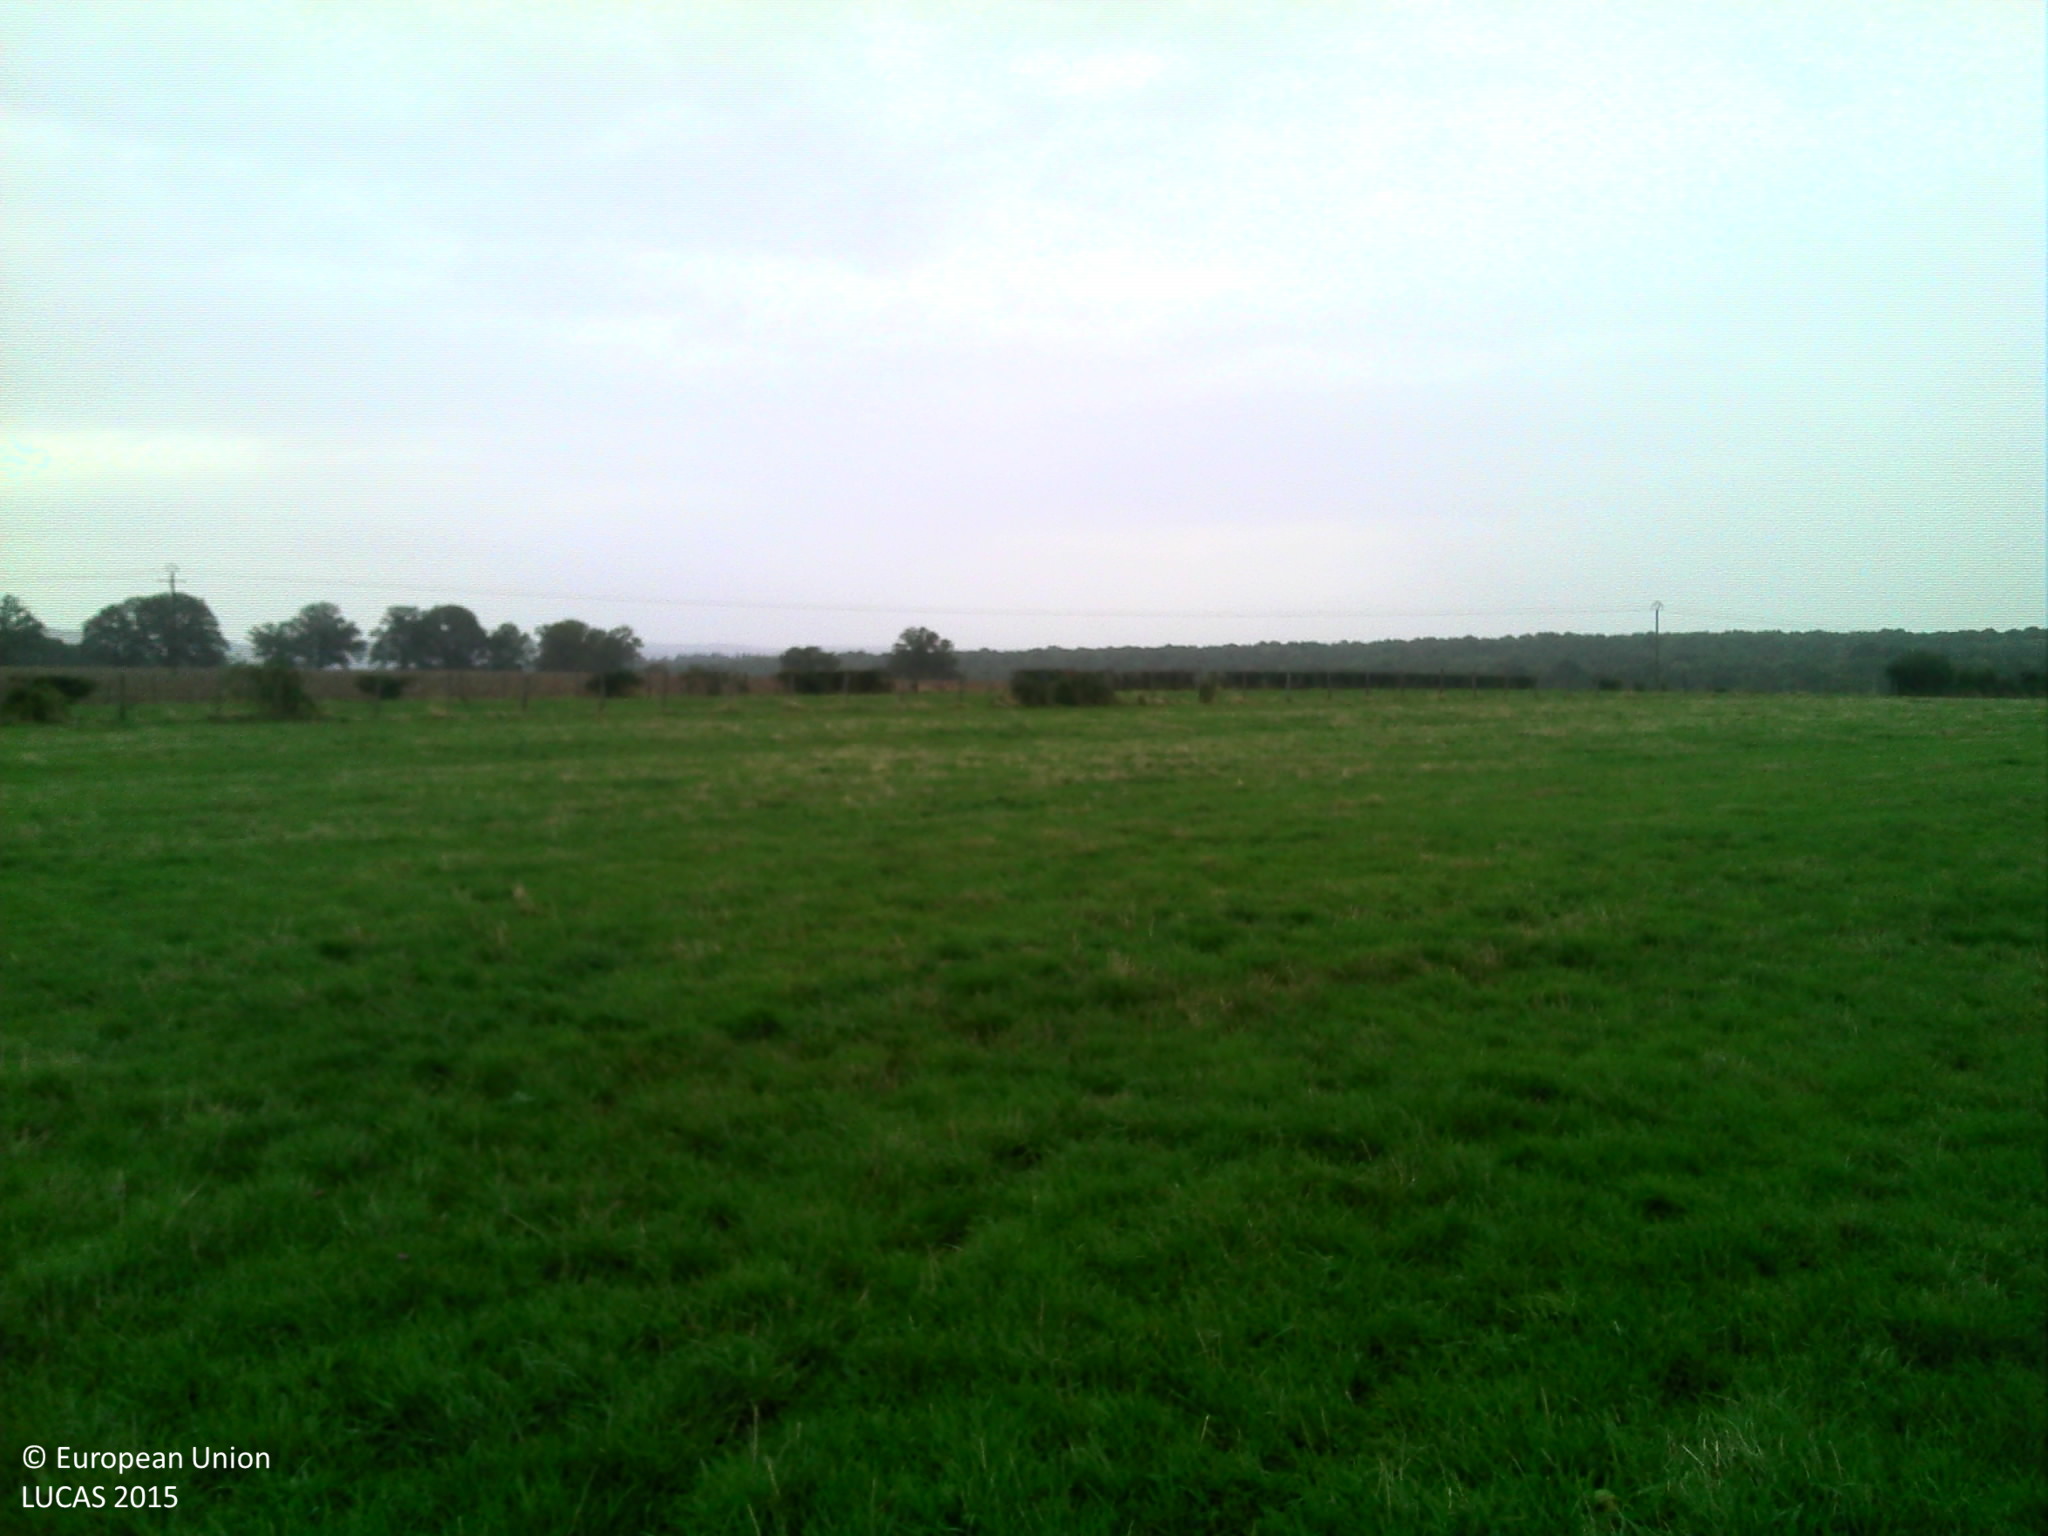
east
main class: Grassland
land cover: Grassland without tree/shrub cover
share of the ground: > 75 %
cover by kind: herbaceous plants 100 %
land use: Agriculture (excluding fallow land and kitchen gardens)
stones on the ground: < 10 %
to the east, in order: Grassland without tree/shrub cover; Fences; Grassland without tree/shrub cover; Managed hedges; Fences; Other bare soil; Electric lines; Other bare soil
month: September
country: FR
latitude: 47.4631
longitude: 4.3076
